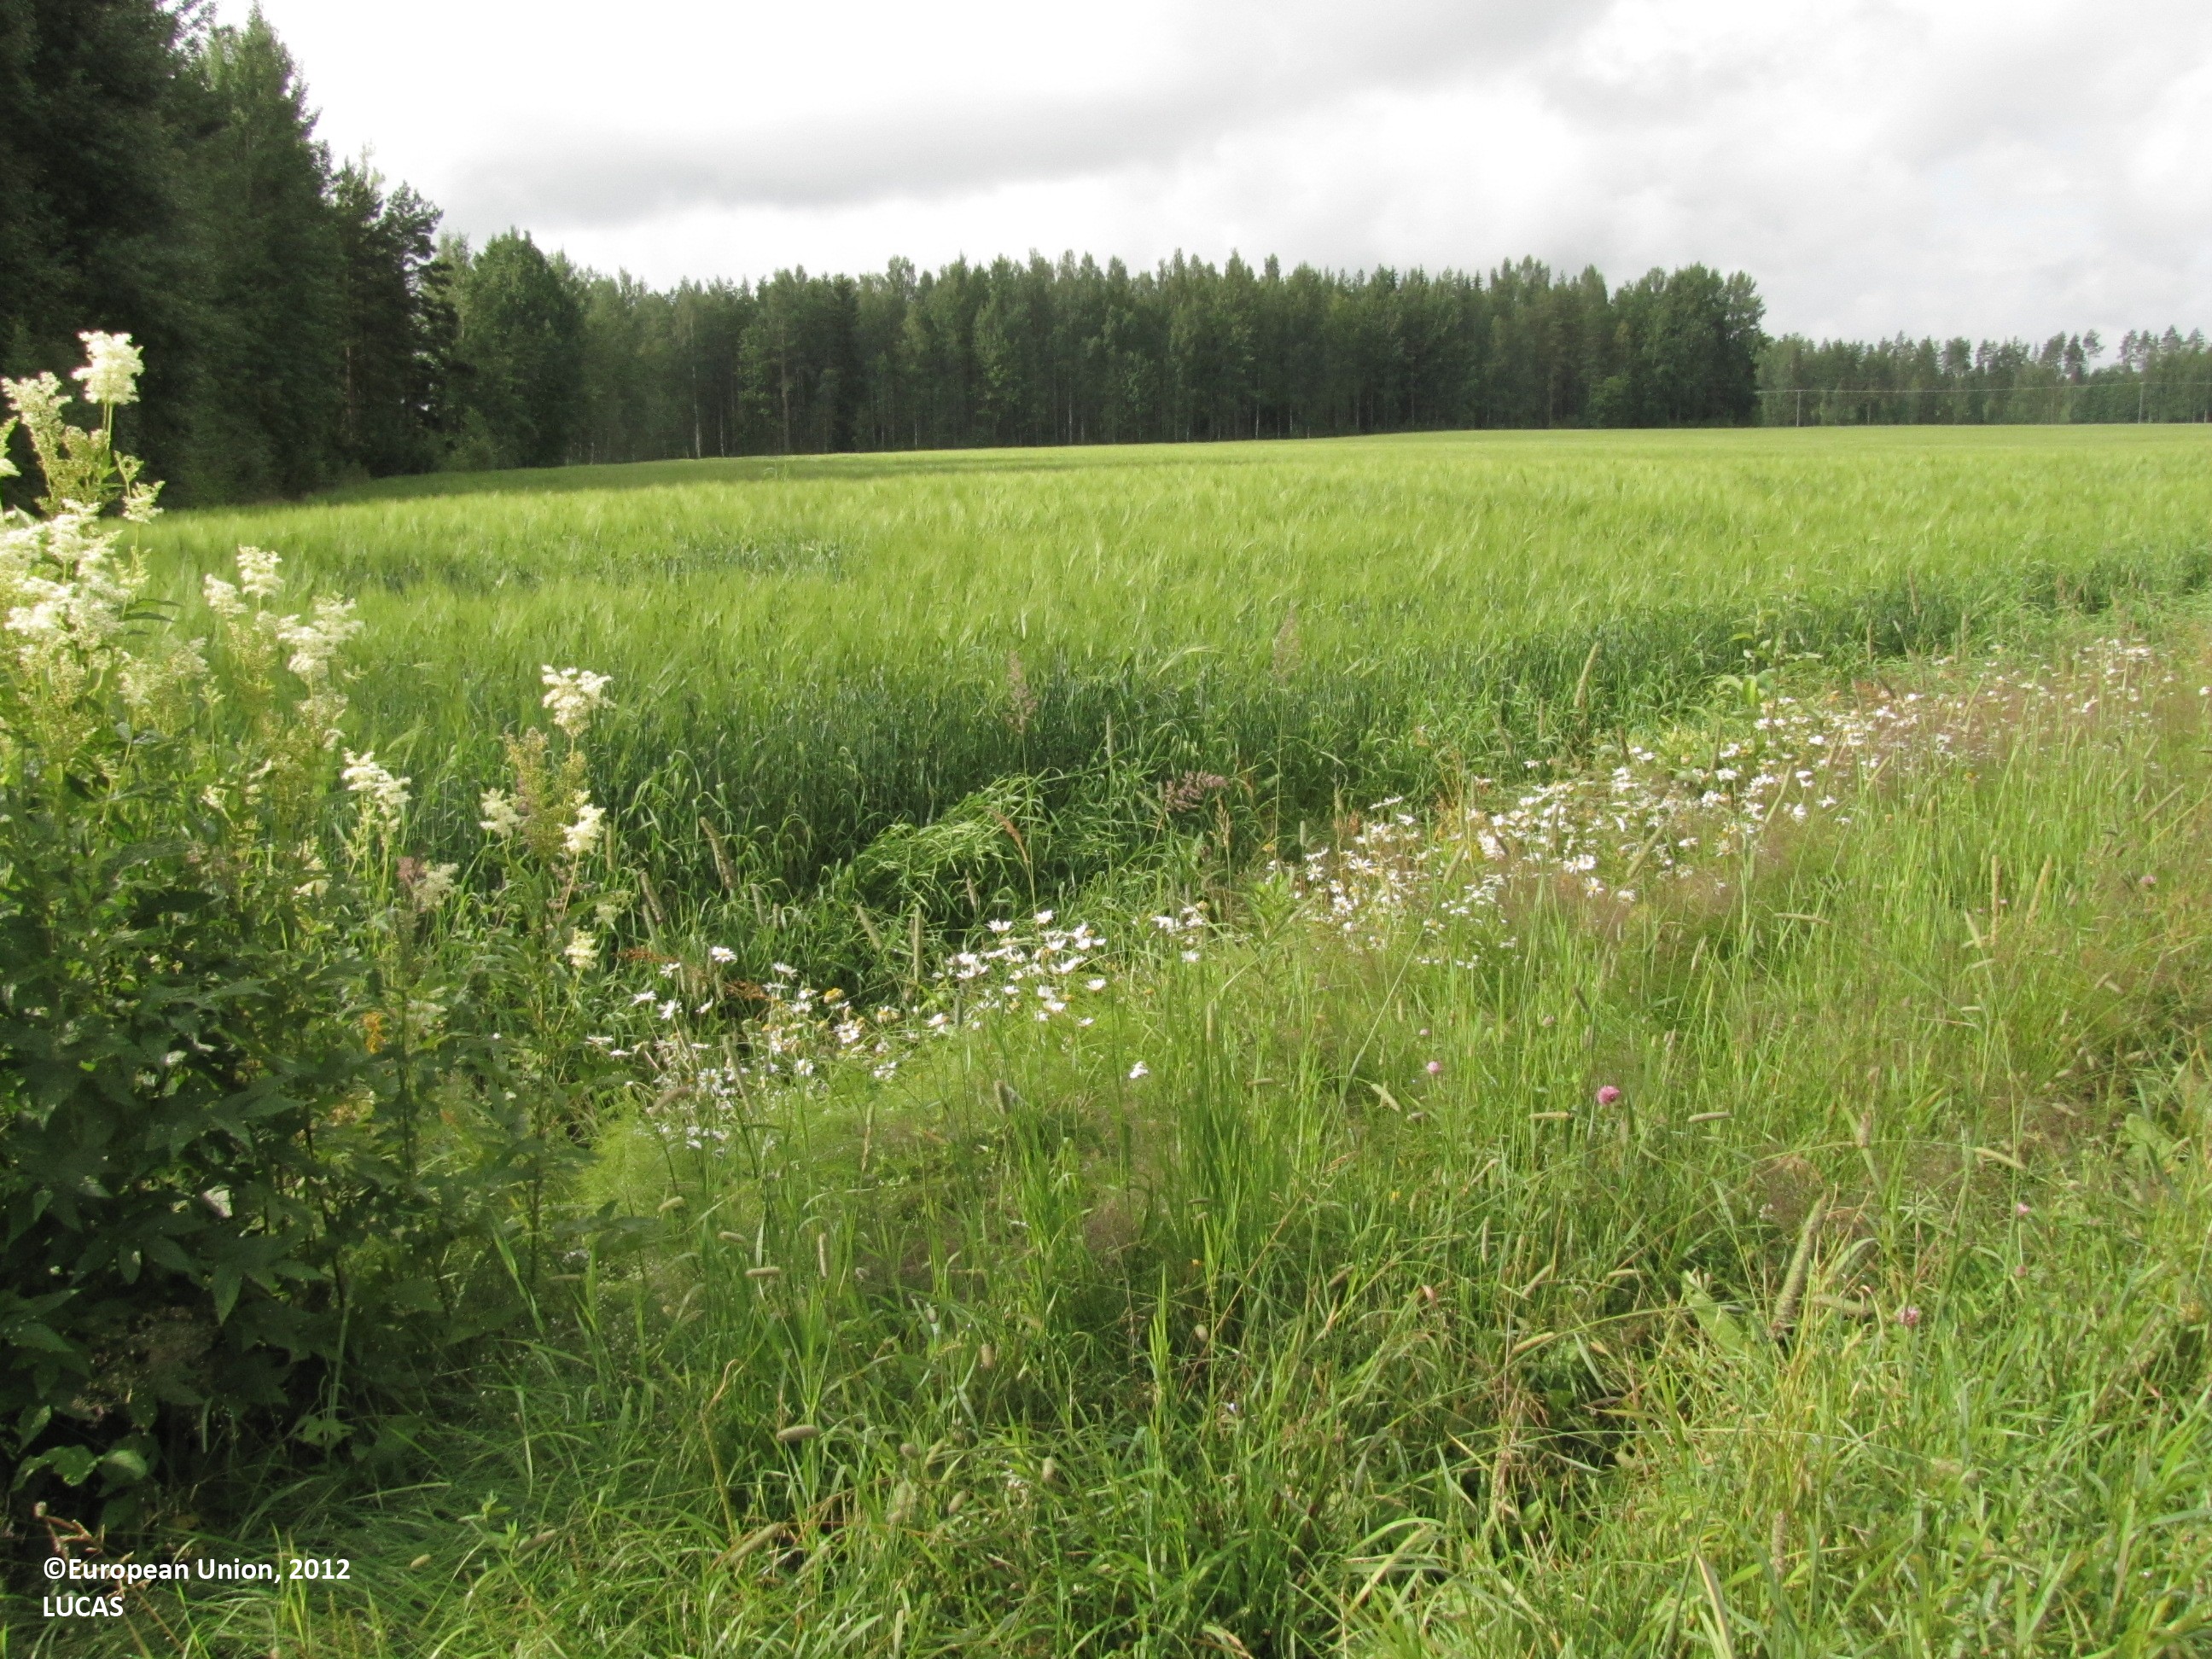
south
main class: Cropland
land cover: Oats
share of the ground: > 75 %
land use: Agriculture (excluding fallow land and kitchen gardens)
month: July
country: FI
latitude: 62.1650
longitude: 23.1026
